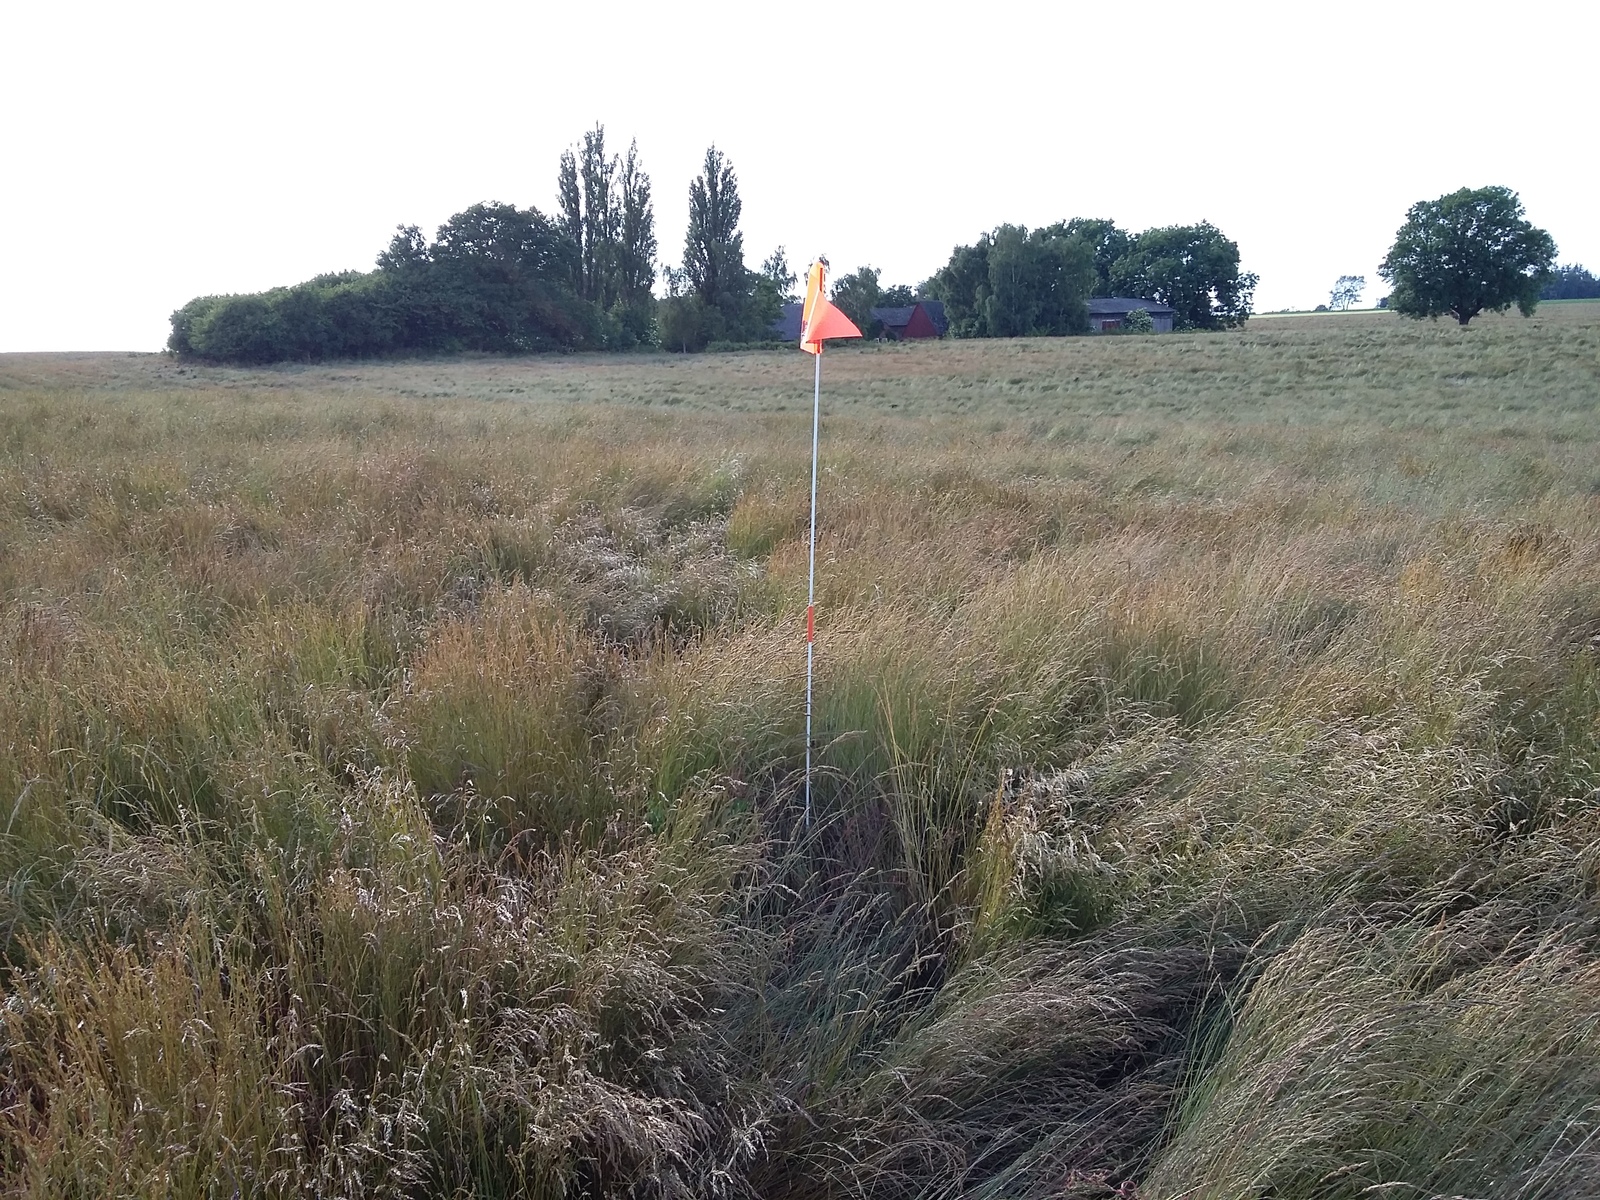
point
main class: Cropland
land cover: Temporary grasslands
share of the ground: > 75 %
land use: Agriculture (excluding fallow land and kitchen gardens)
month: June
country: DK
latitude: 54.8041
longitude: 12.0990
